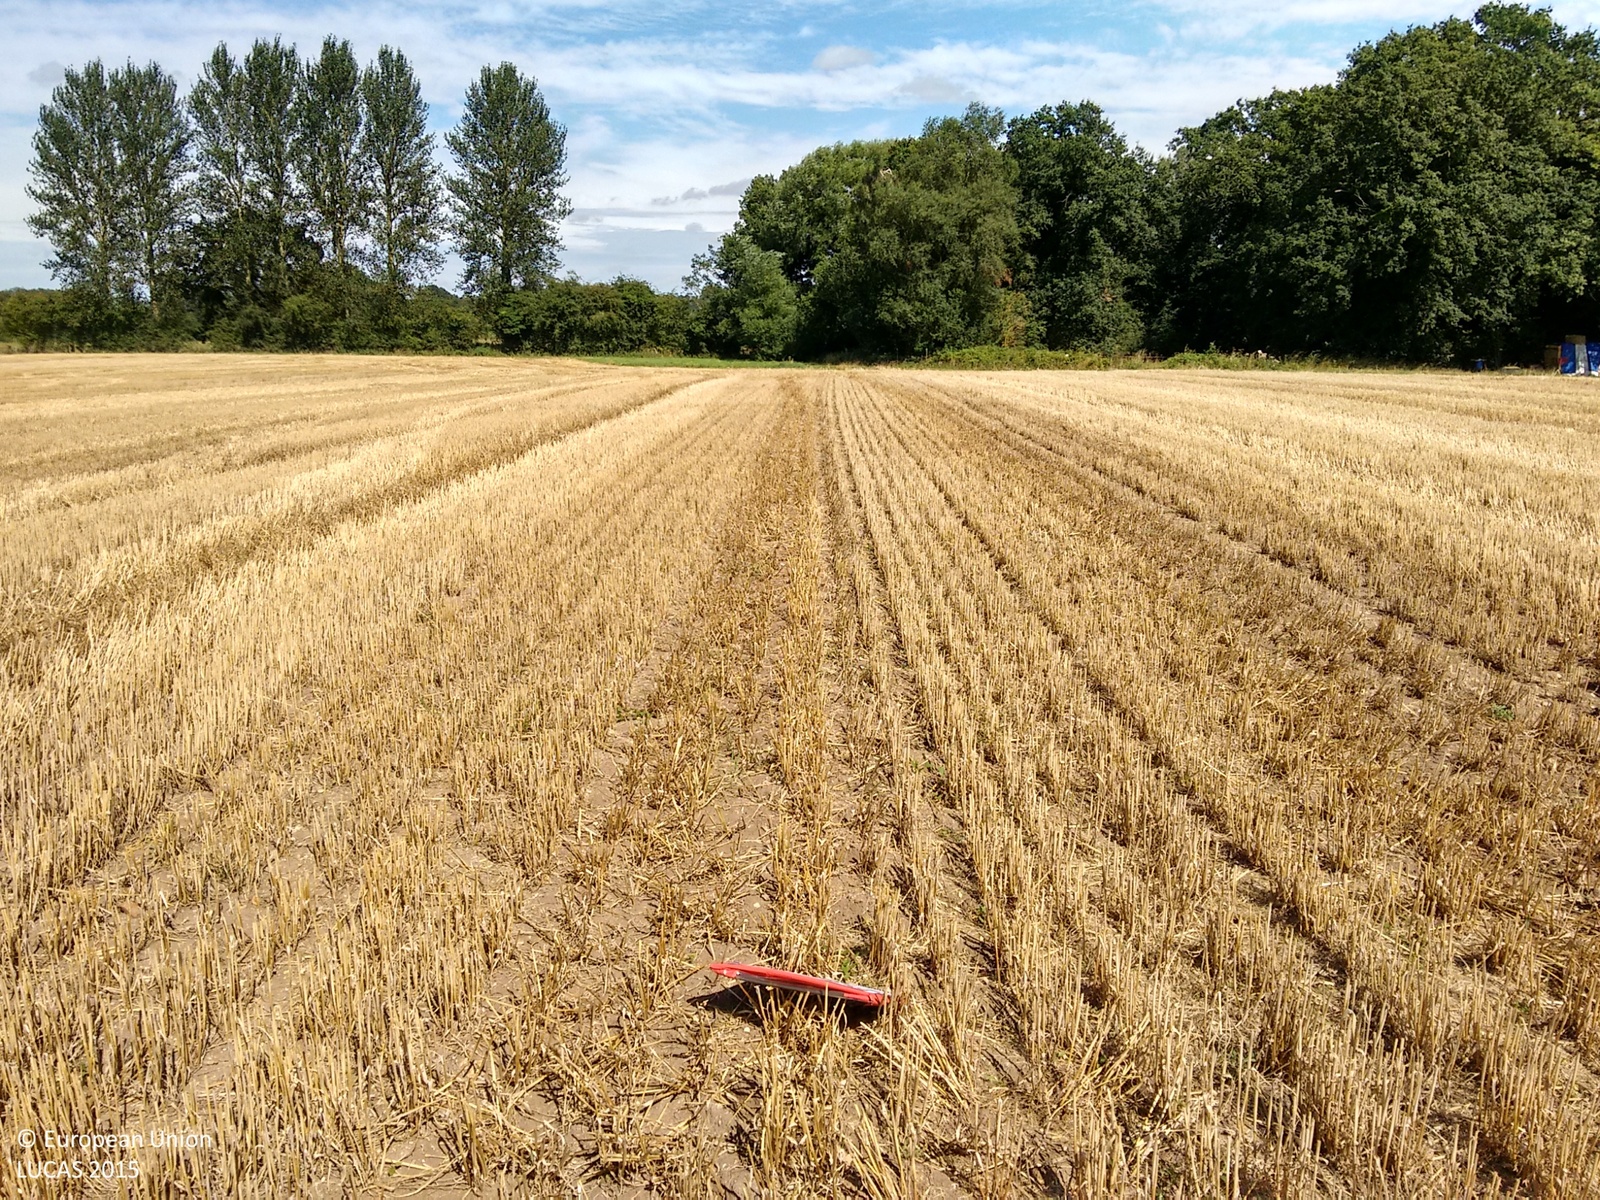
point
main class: Cropland
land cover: Common wheat
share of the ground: > 75 %
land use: Agriculture (excluding fallow land and kitchen gardens)
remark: Harvested field
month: August
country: GB
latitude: 52.7261
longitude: 0.8099
